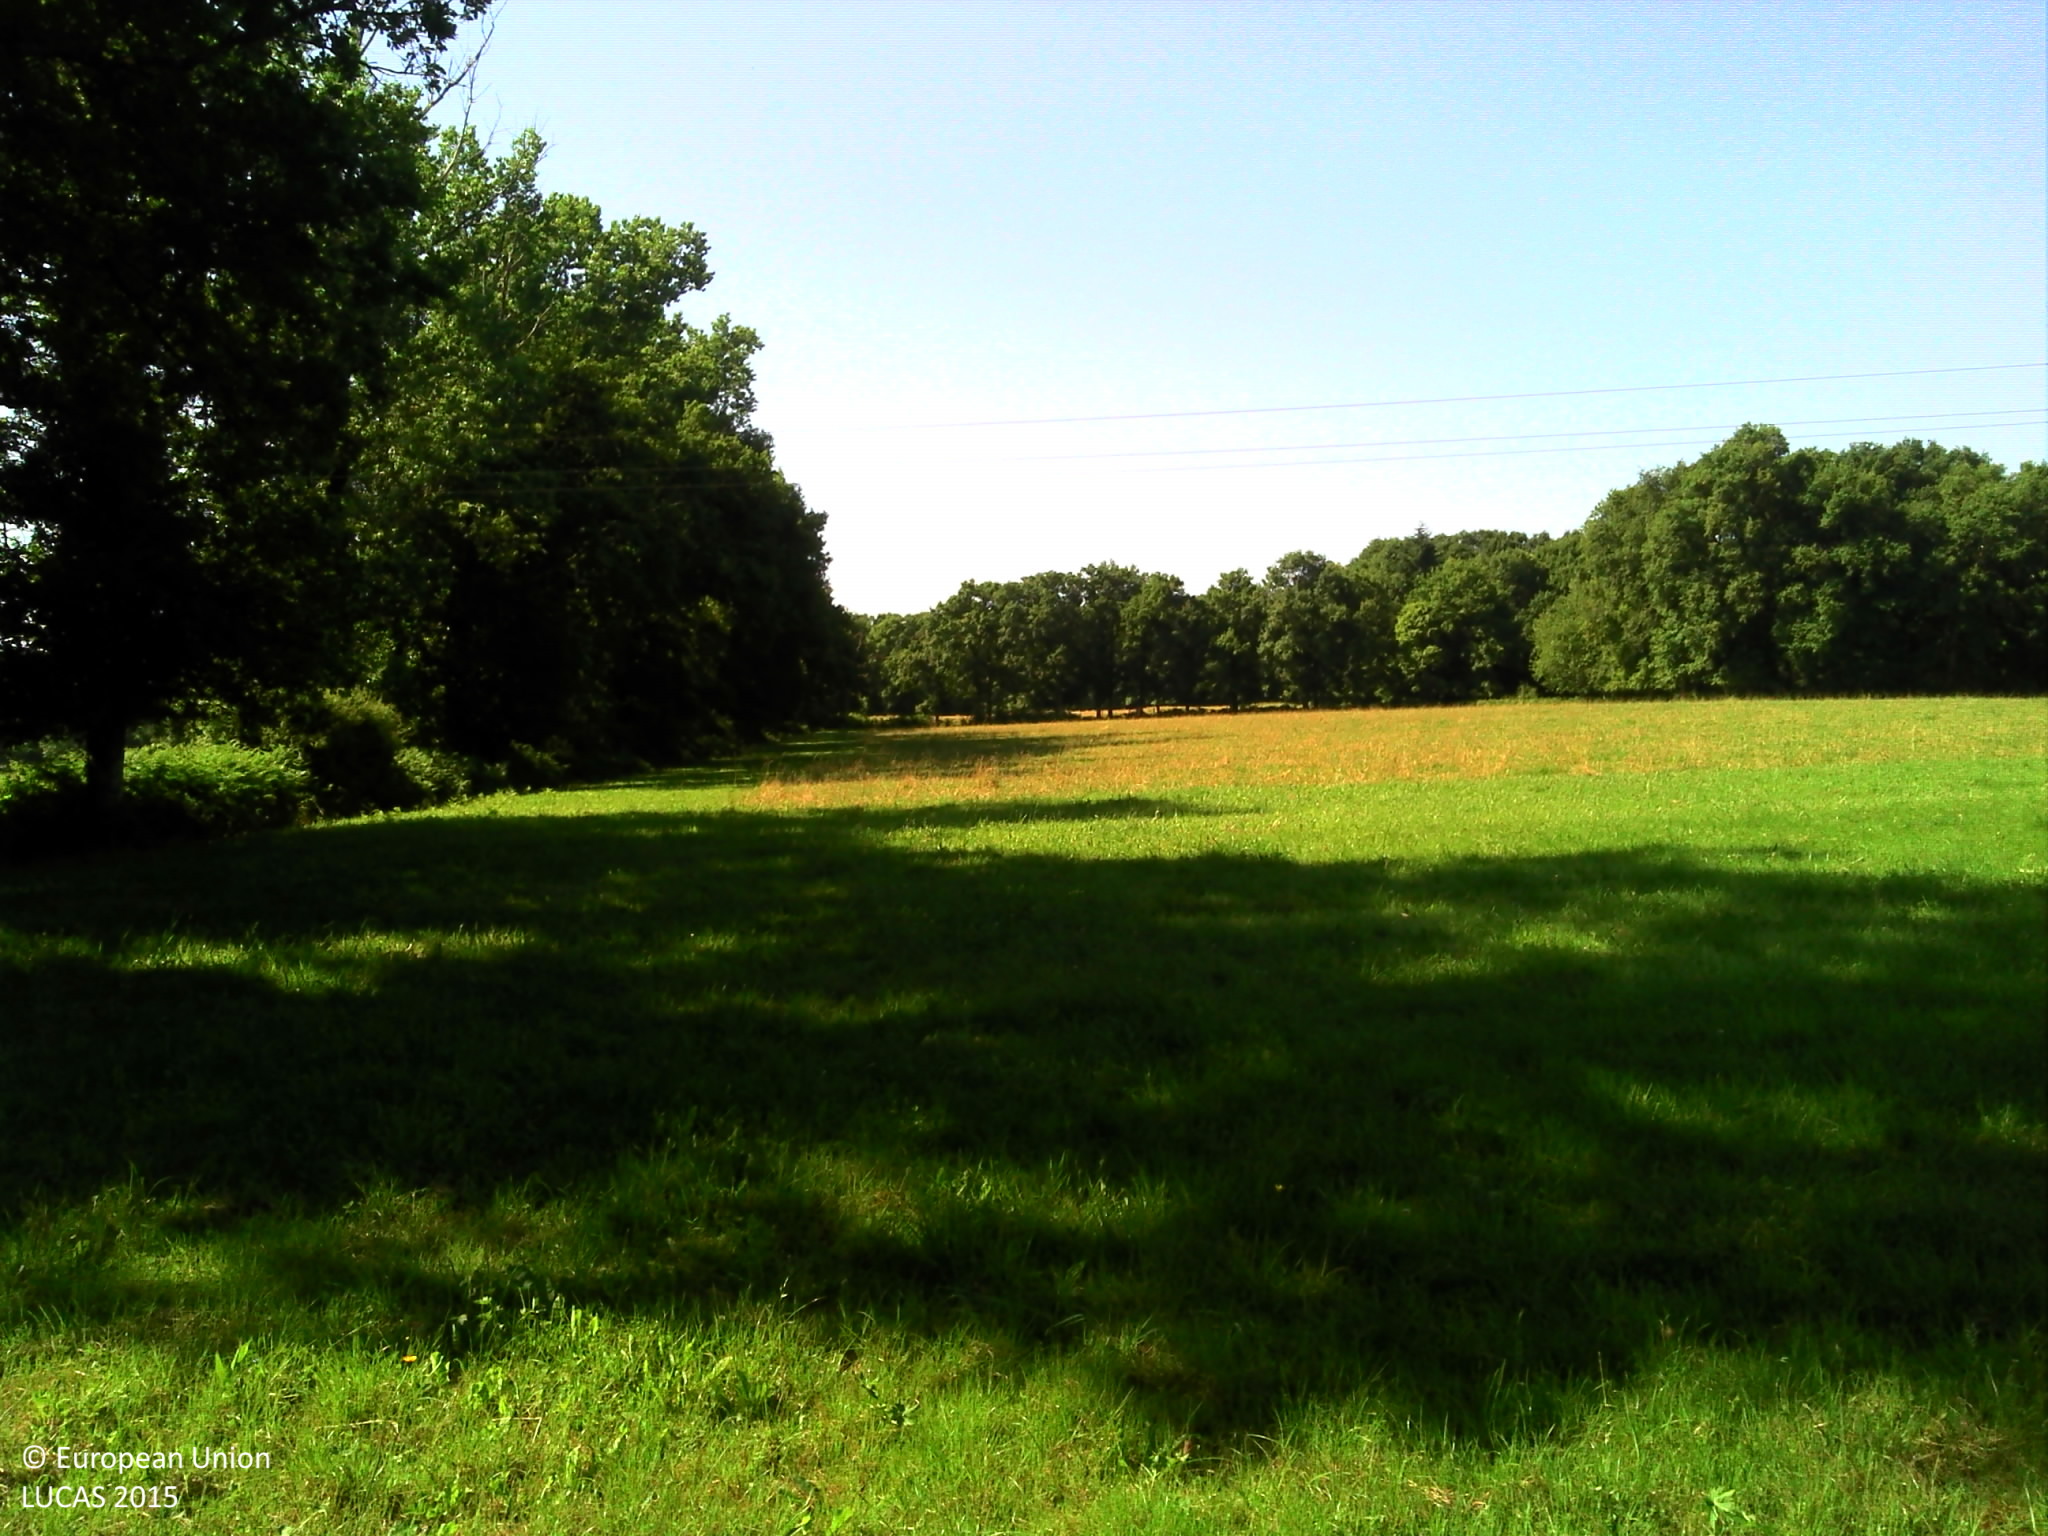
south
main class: Grassland
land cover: Grassland without tree/shrub cover
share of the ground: > 75 %
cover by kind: herbaceous plants 100 %
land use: Agriculture (excluding fallow land and kitchen gardens)
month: June
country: FR
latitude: 45.9015
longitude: 0.6153
